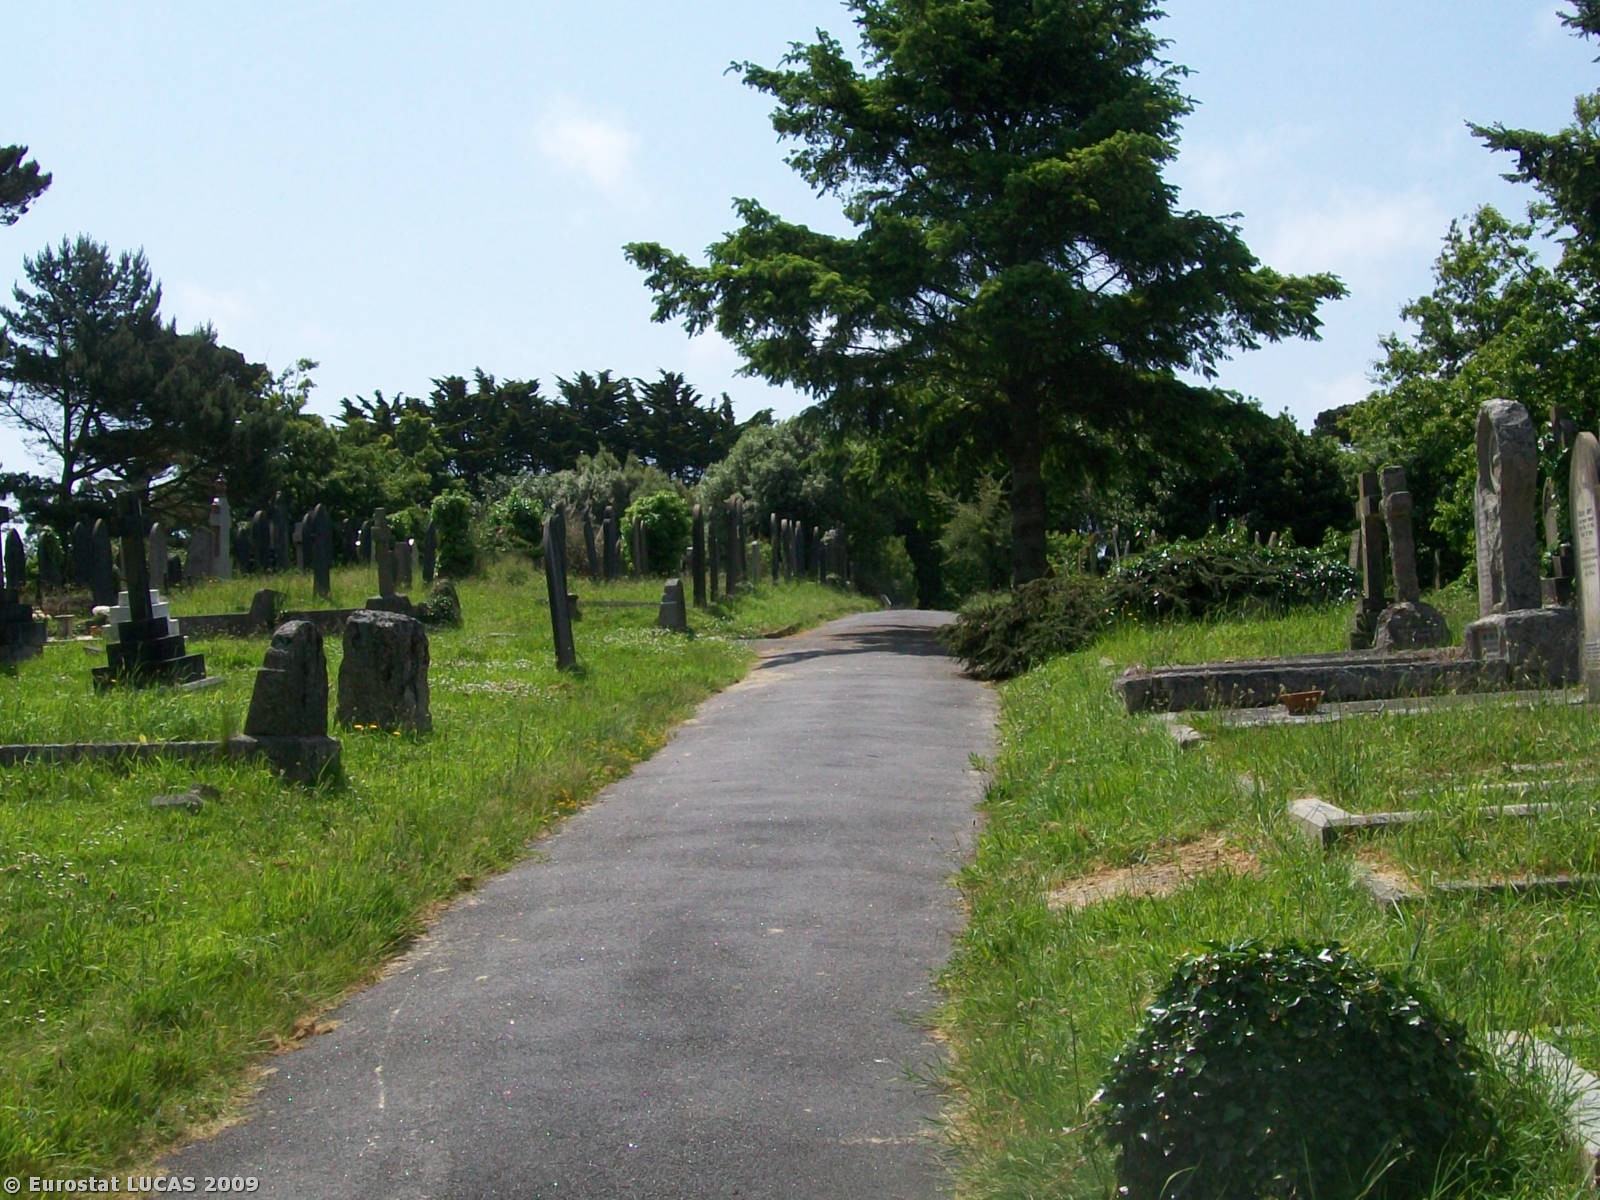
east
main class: Grassland
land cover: Grassland with sparse tree/shrub cover
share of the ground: > 75 %
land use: Community services
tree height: > 5 m
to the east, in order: Grassland with sparse tree/shrub cover; Managed hedges; Paved roads, cycling and walking lanes; Artificial constructions in urban areas
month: June
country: GB
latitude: 50.1440
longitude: -5.0757
